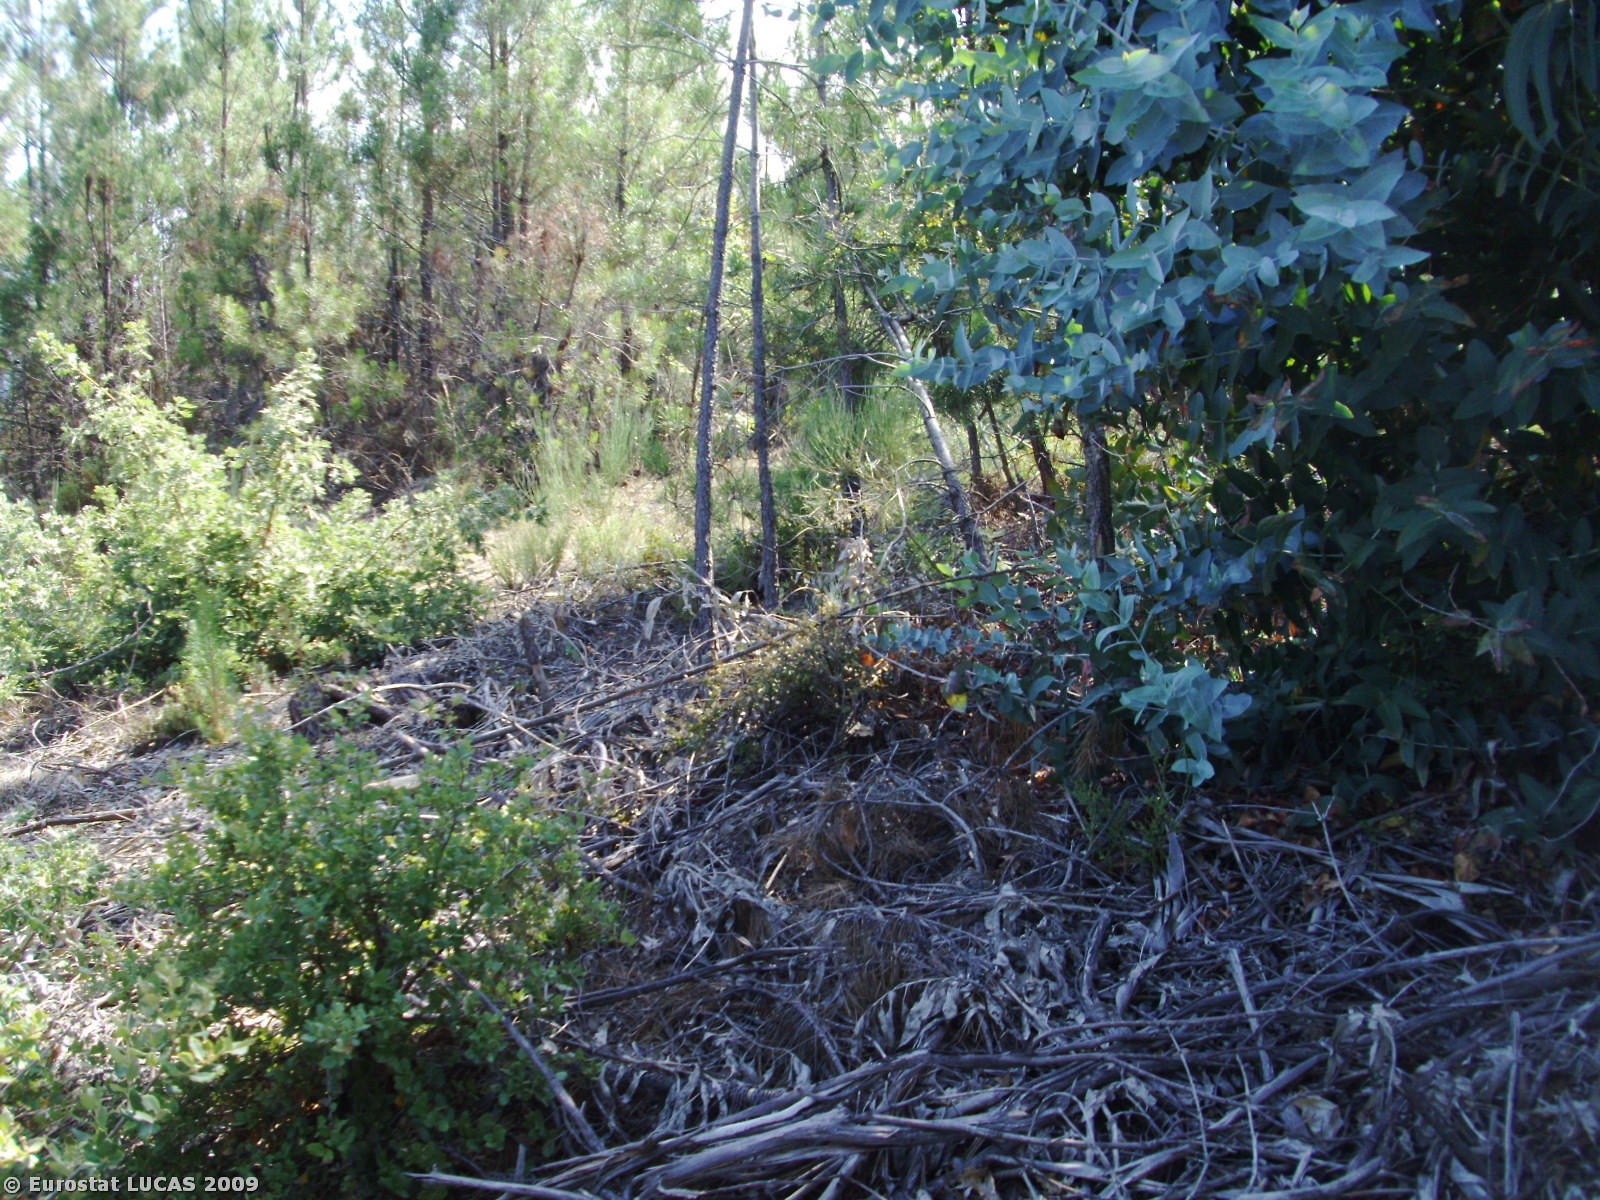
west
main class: Woodland
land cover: Coniferous woodland
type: coniferous forest of the mediterranean region
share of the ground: 25 - 50 %
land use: Forestry
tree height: > 5 m
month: July
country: PT
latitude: 40.2484
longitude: -7.3008
